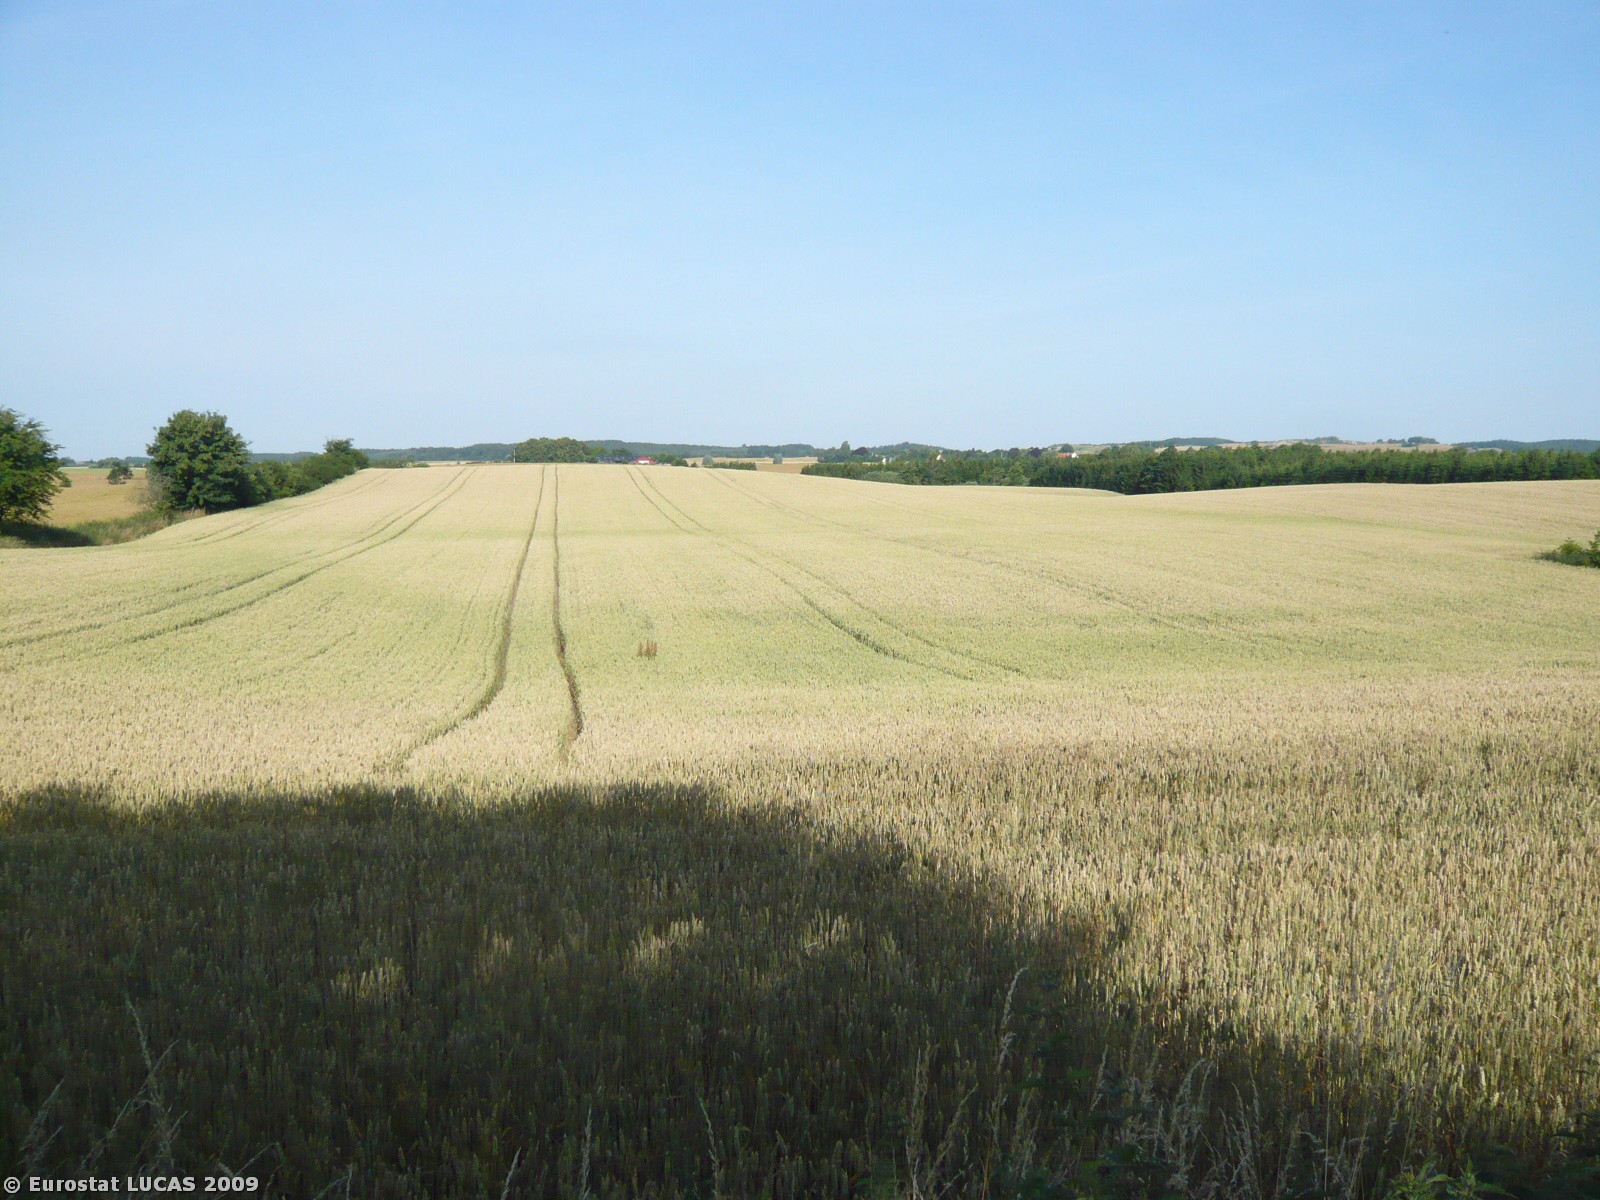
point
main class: Cropland
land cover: Common wheat
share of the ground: > 75 %
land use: Agriculture (excluding fallow land and kitchen gardens)
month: July
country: DK
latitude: 55.6008
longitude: 11.7284
